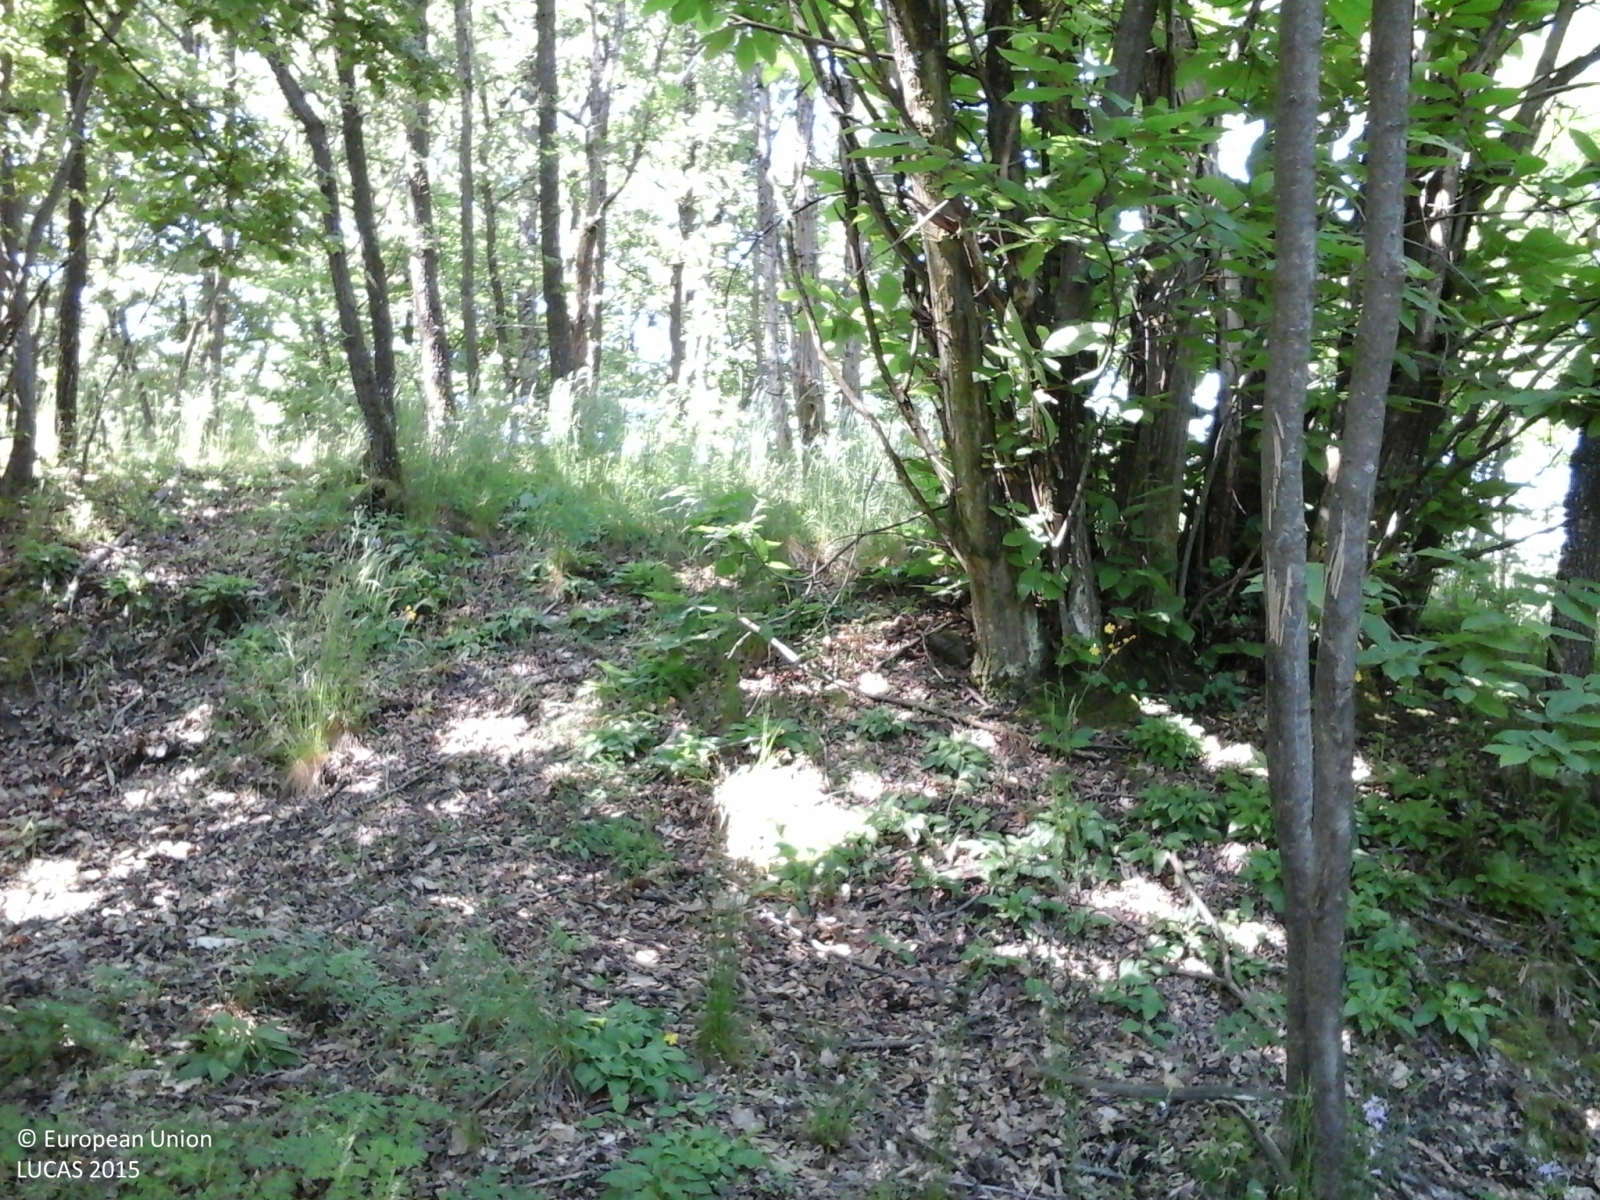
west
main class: Woodland
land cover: Broadleaved woodland
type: thermophilous deciduous forest
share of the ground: > 75 %
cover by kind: broadleaved forest trees 90 %, consolidated bare surface 10 %
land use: Forestry
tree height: > 5 m
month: May
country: IT
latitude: 44.4206
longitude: 10.6642
